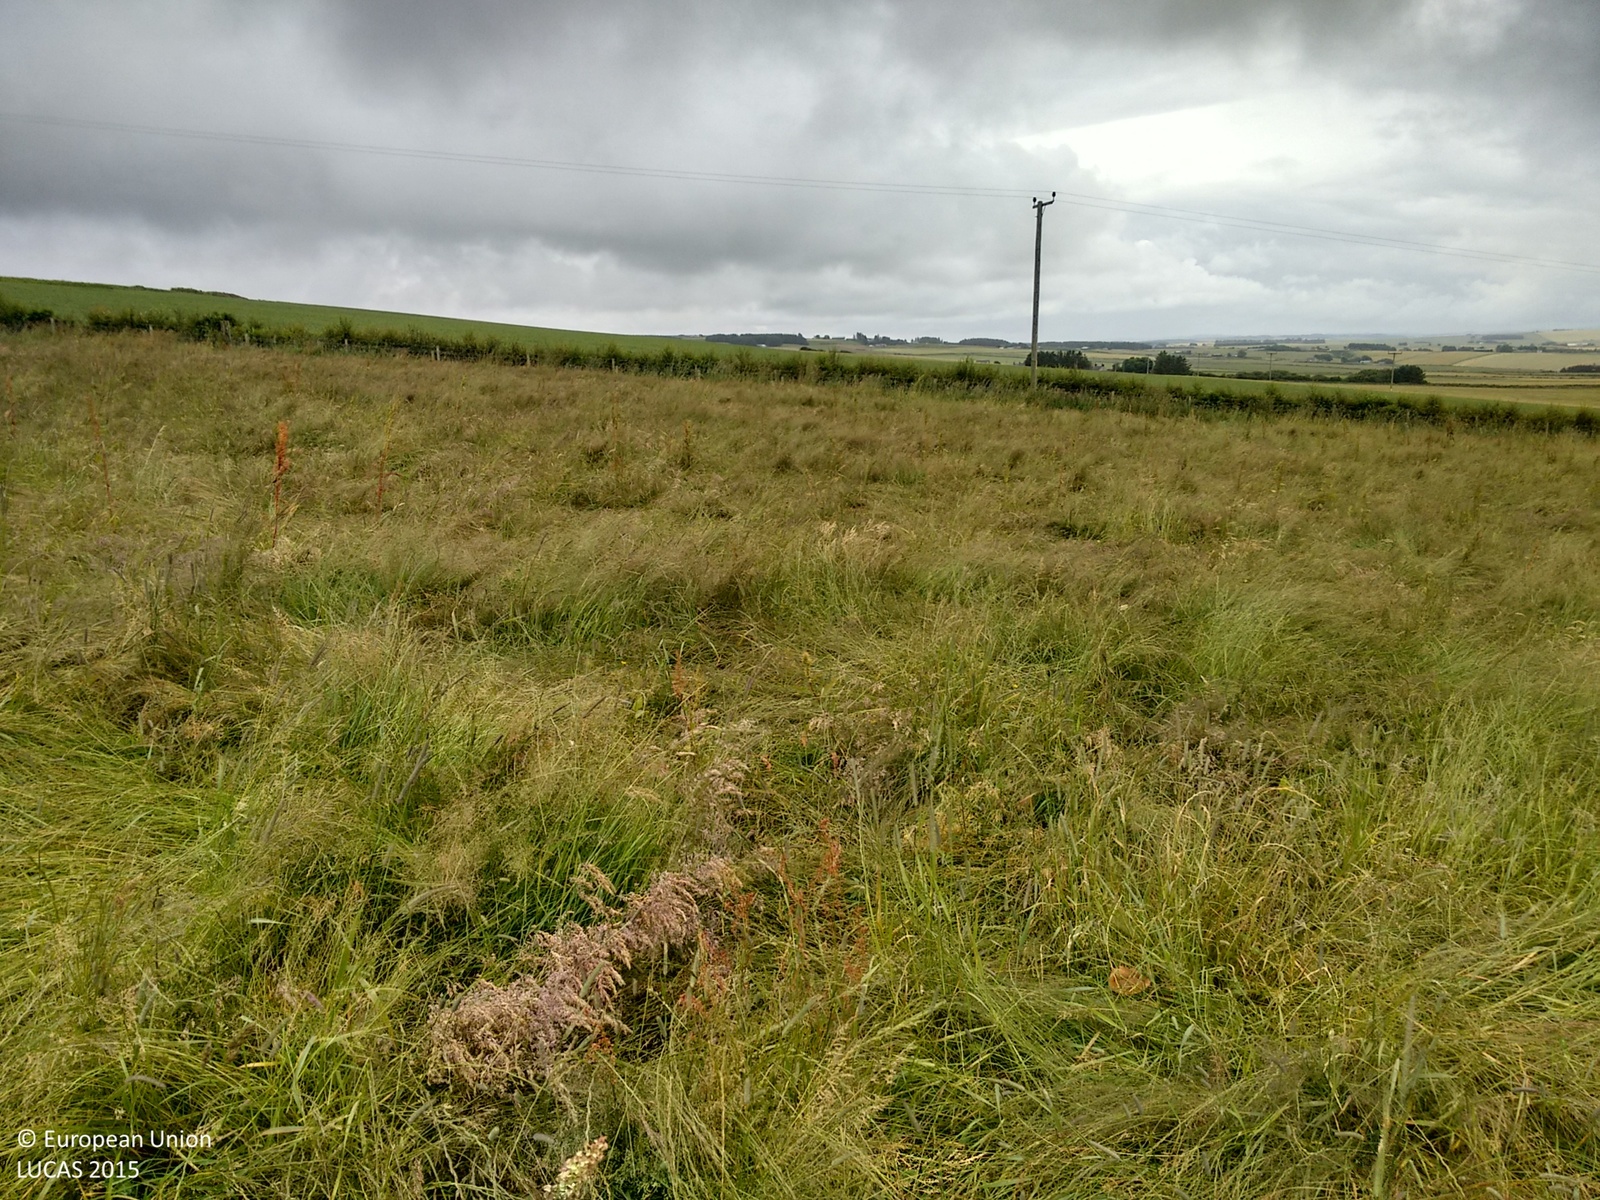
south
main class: Grassland
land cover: Grassland without tree/shrub cover
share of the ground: > 75 %
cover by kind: herbaceous plants 100 %
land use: Agriculture (excluding fallow land and kitchen gardens)
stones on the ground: 25 - 50 %
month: July
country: GB
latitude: 57.6313
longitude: -2.3252
